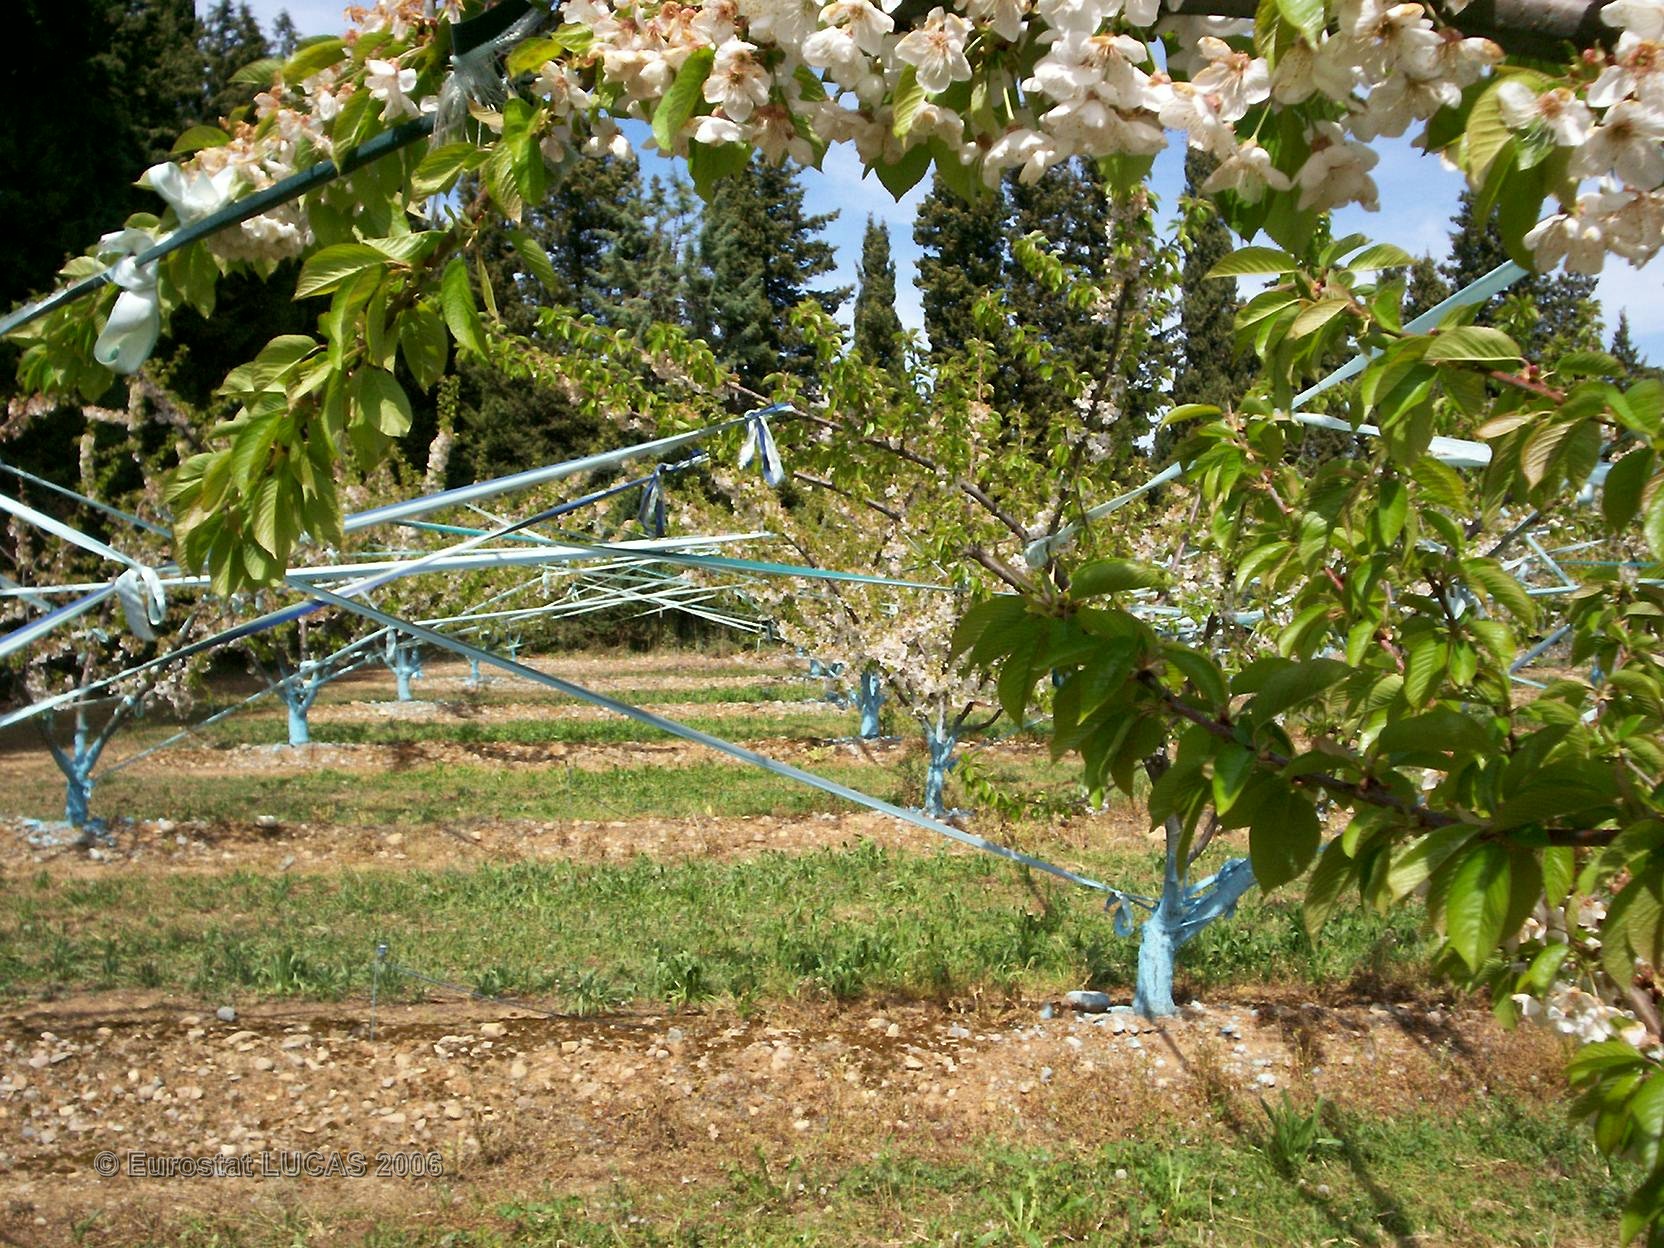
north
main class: Cropland
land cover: Cherry fruit
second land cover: Grassland with sparse tree/shrub cover
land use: Agriculture (excluding fallow land and kitchen gardens)
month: April
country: FR
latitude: 43.6872
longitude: 4.9850
